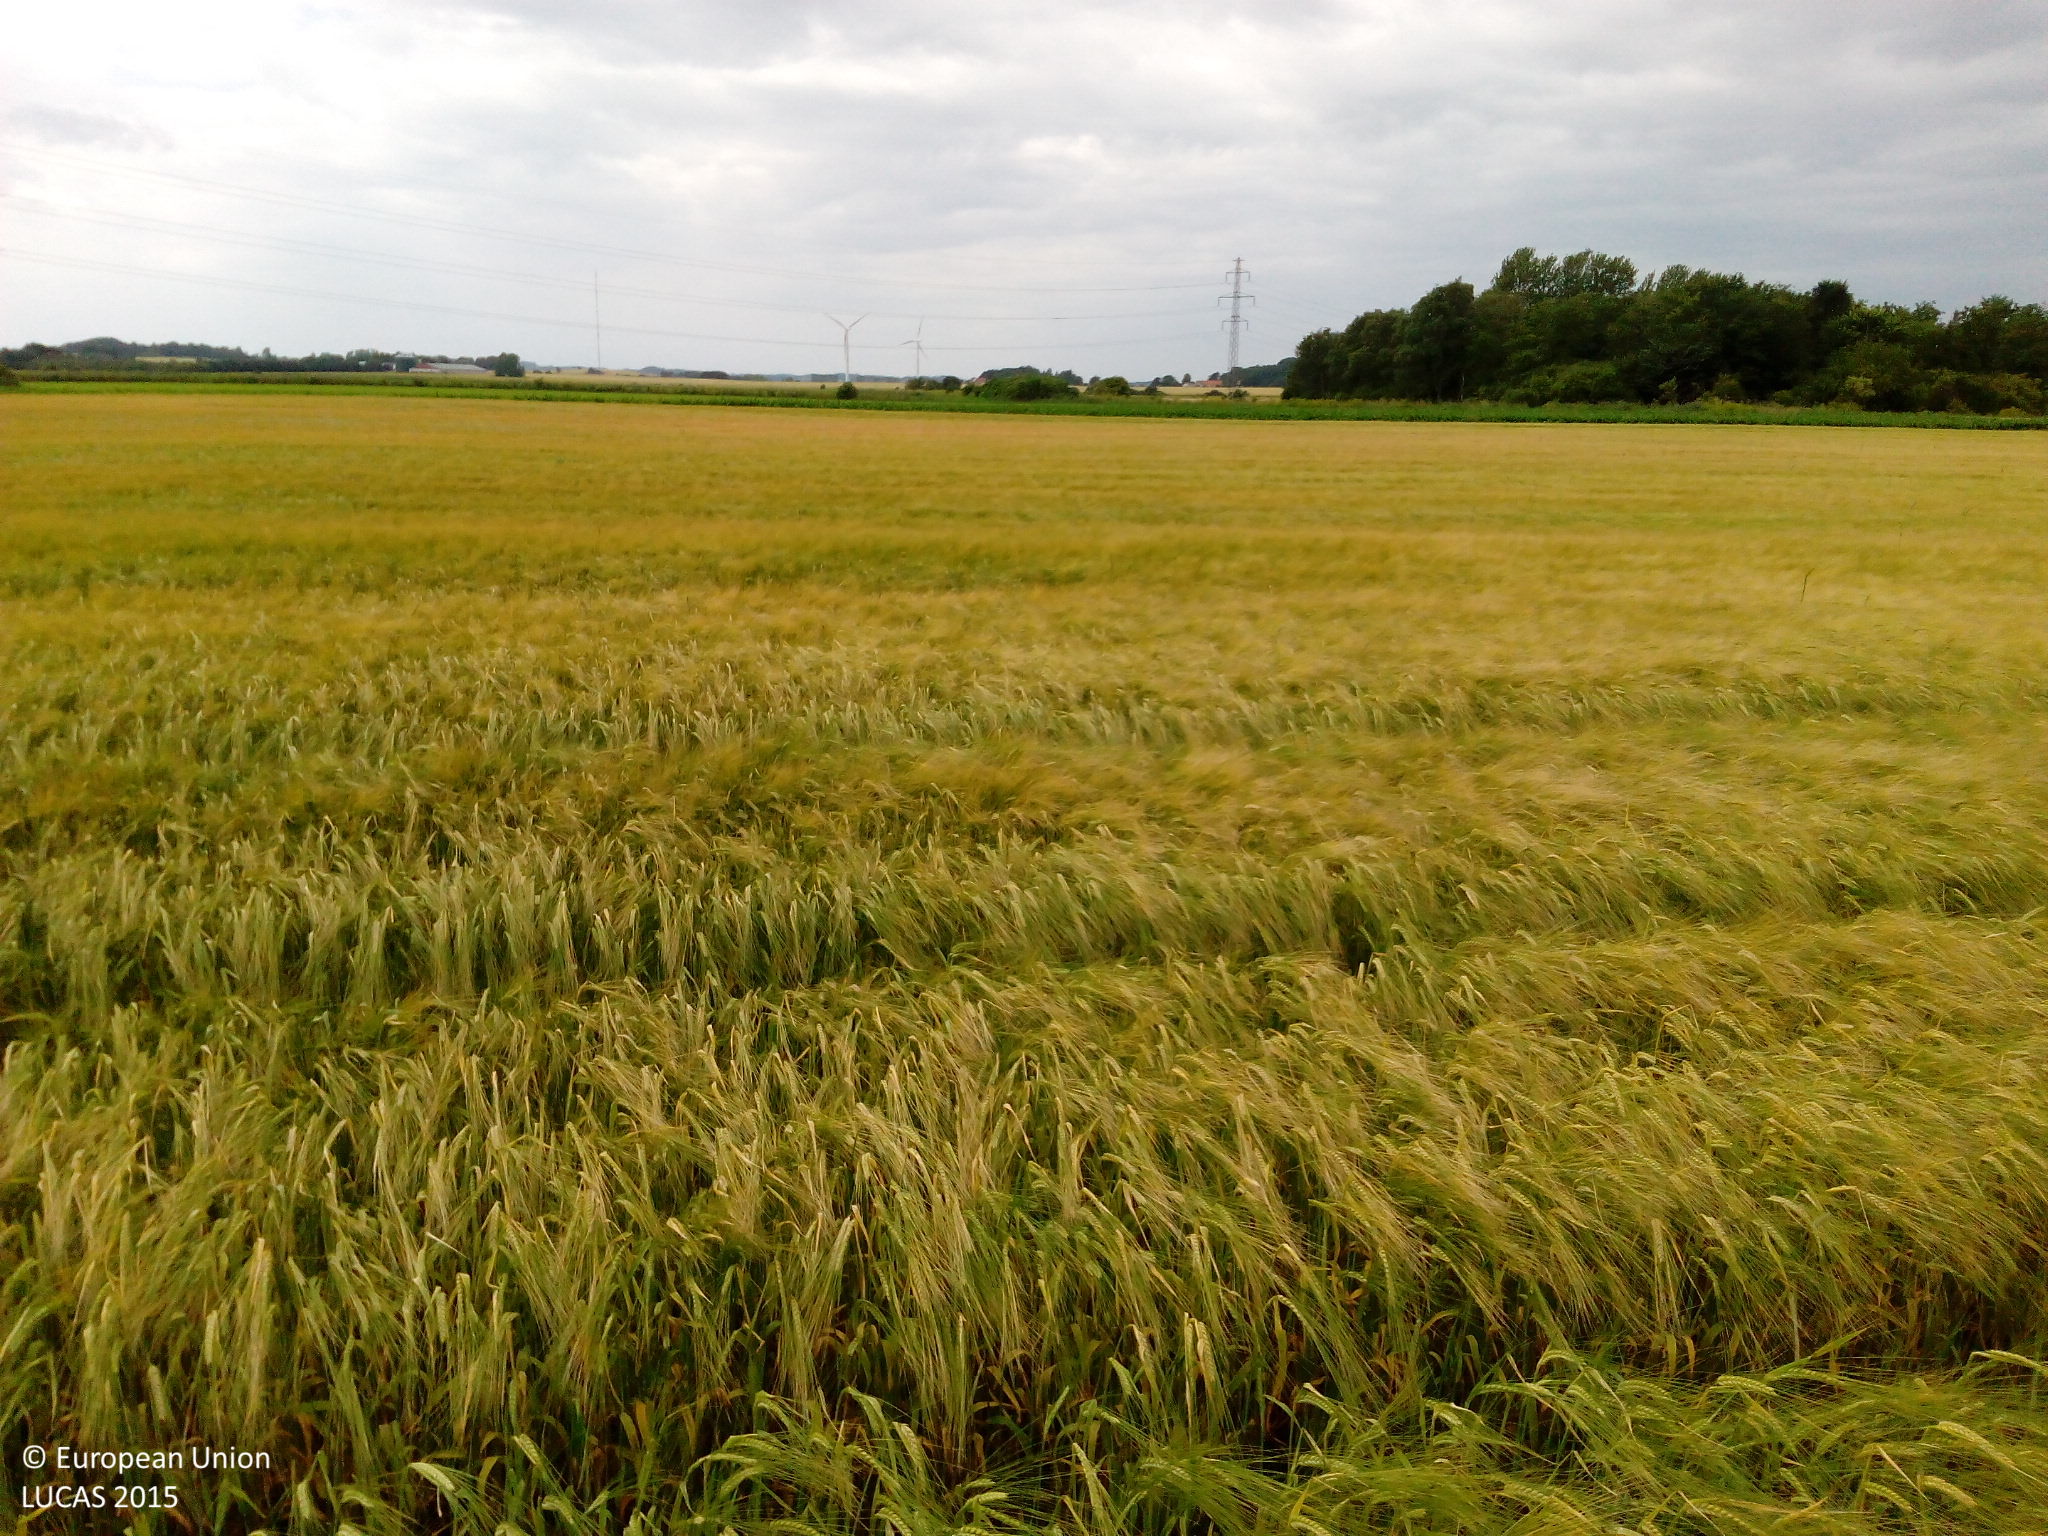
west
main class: Cropland
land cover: Barley
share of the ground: > 75 %
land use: Agriculture (excluding fallow land and kitchen gardens)
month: July
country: DK
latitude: 55.6931
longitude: 11.5417
